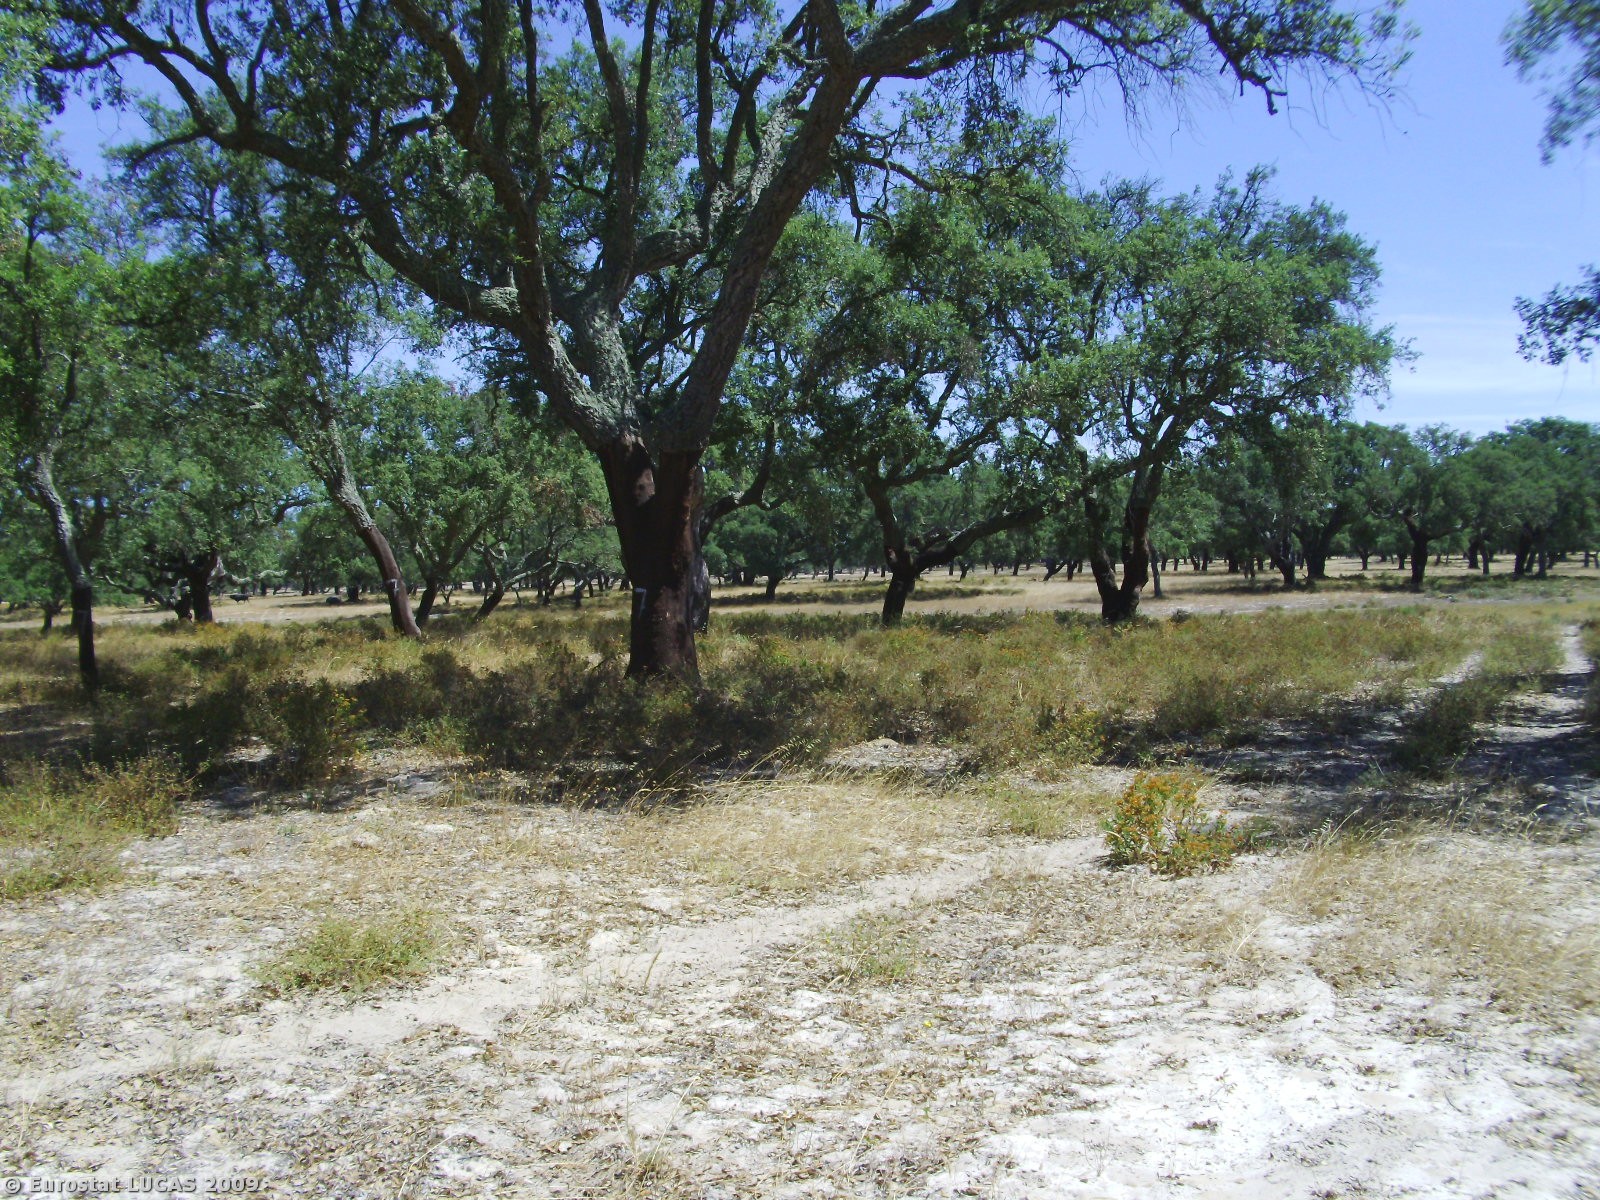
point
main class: Woodland
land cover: Broadleaved woodland
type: broadleaved evergreen forest
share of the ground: 10 - 25 %
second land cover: Spontaneously vegetated surfaces
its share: 50 - 75 %
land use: Forestry
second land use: Fallow land
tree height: > 5 m
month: August
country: PT
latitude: 38.7311
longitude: -8.8757
